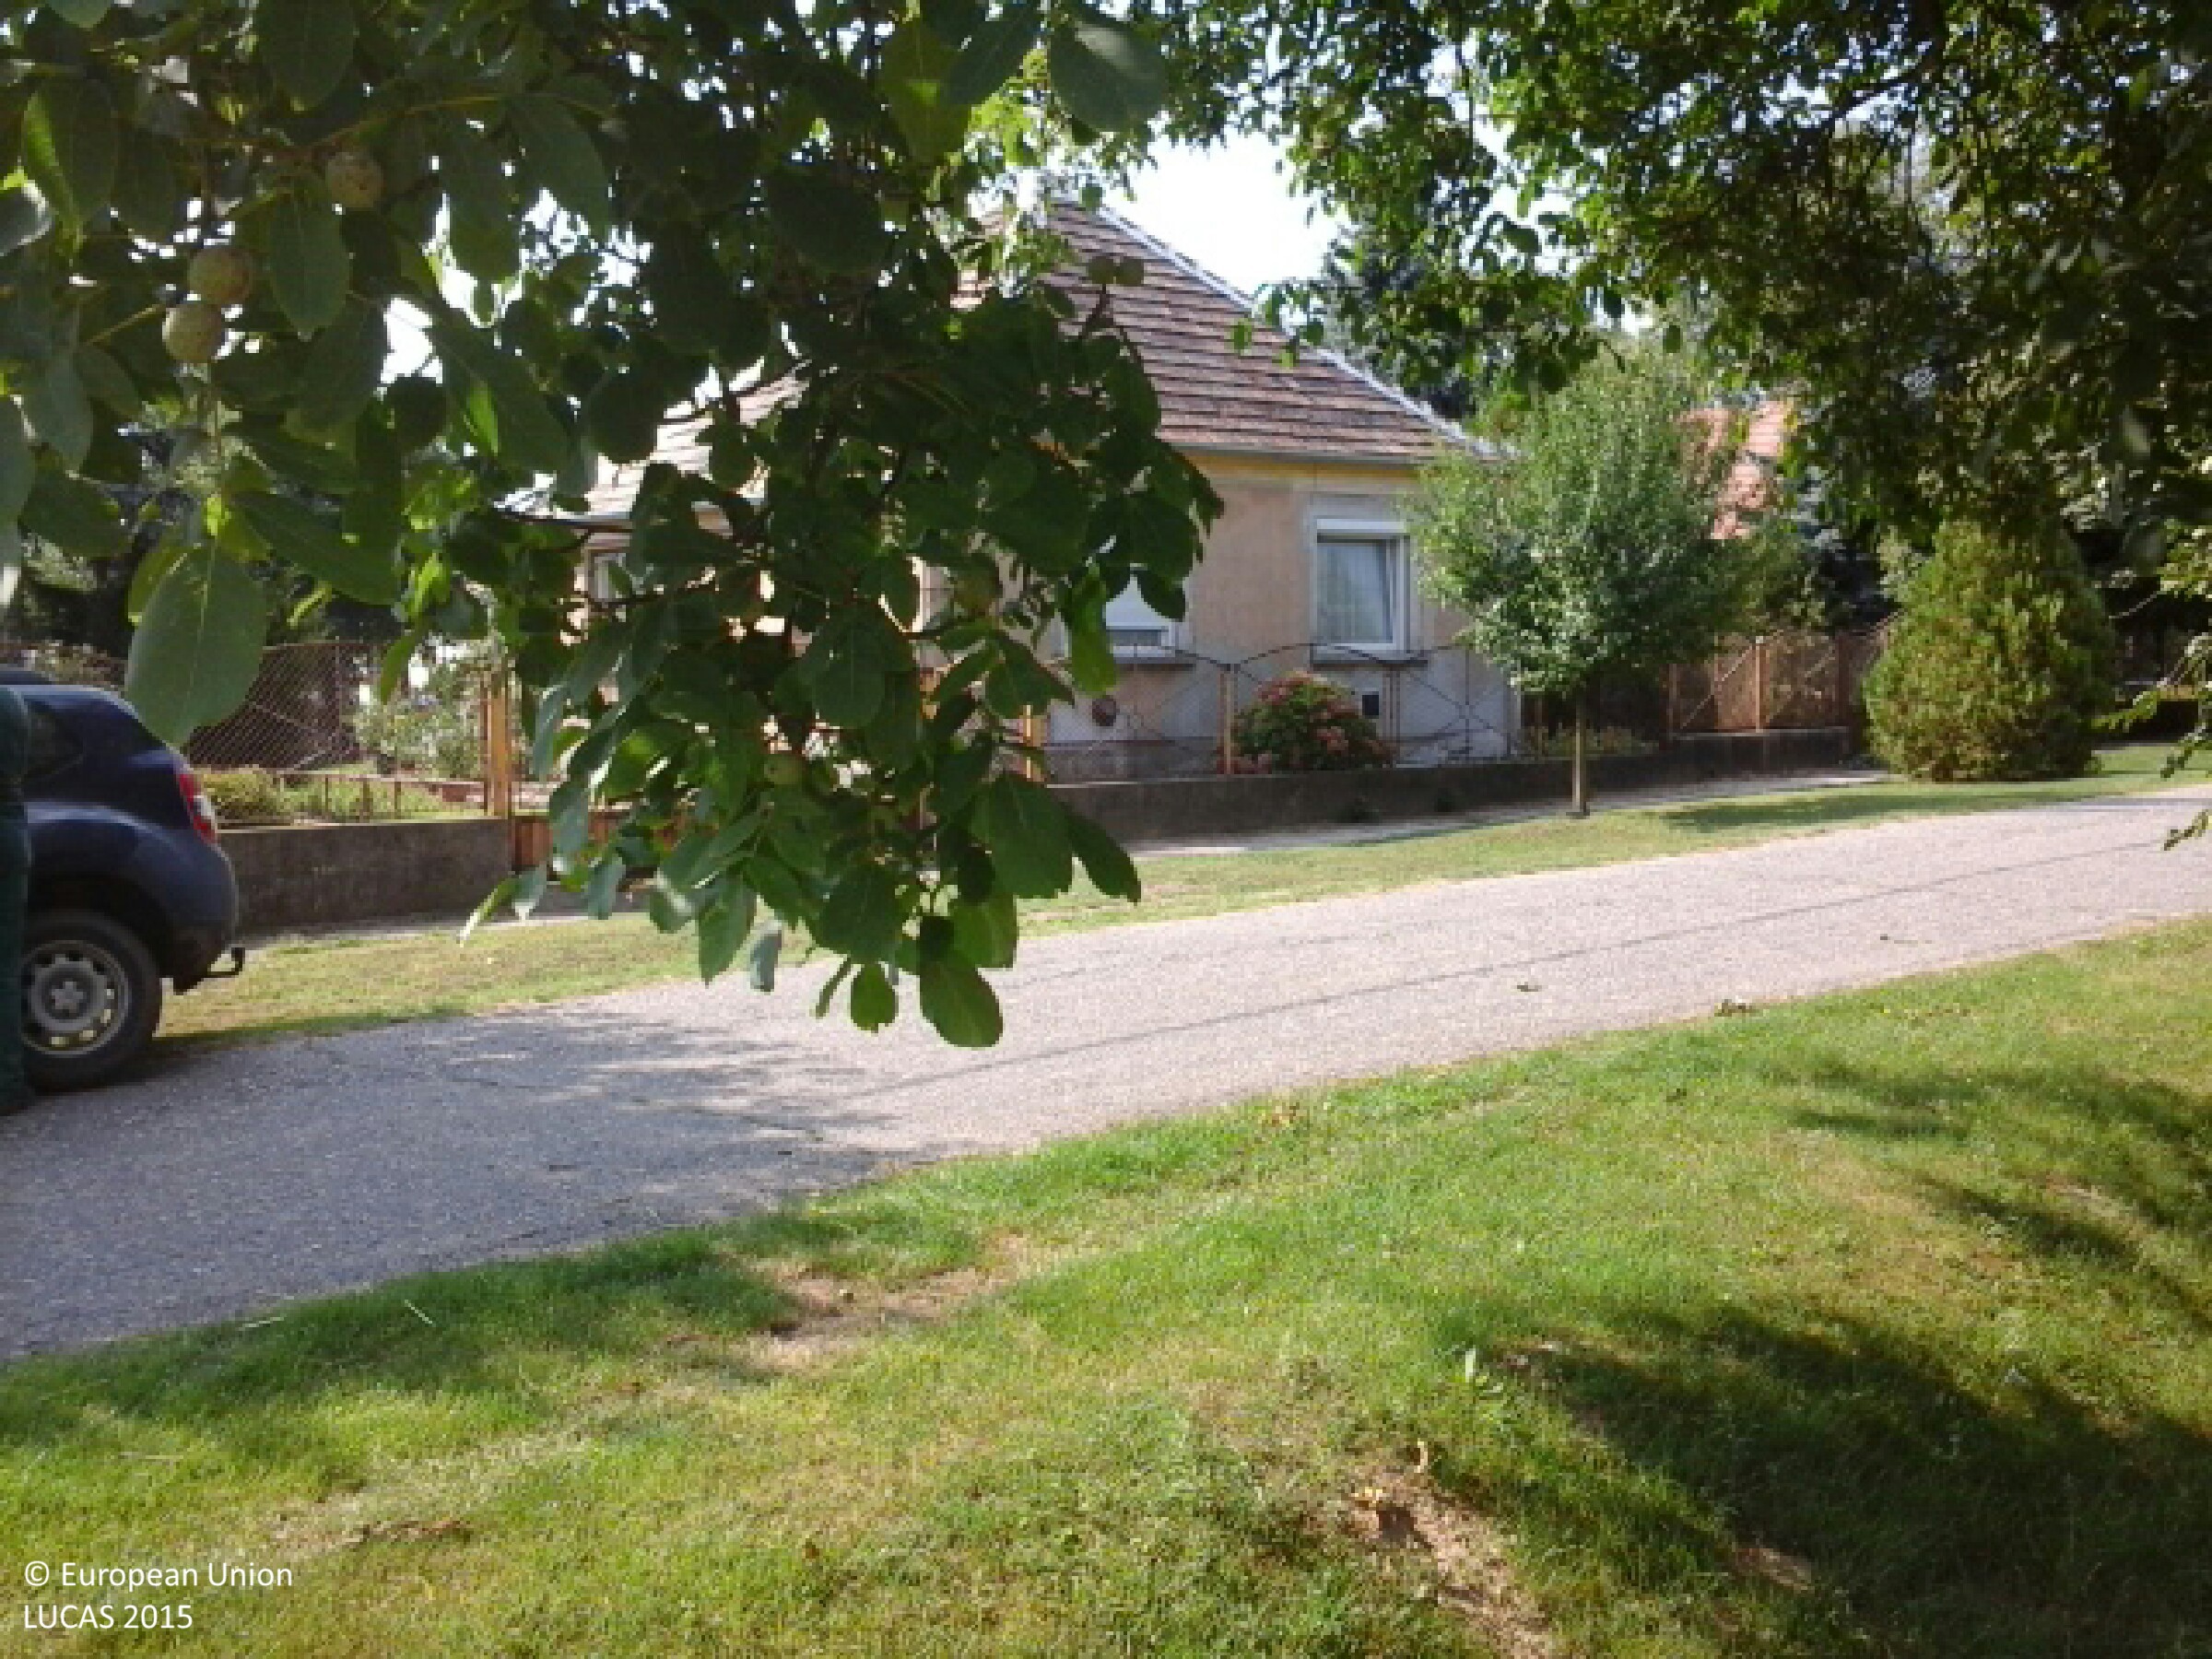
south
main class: Grassland
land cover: Grassland without tree/shrub cover
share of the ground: > 75 %
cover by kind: herbaceous plants 95 %, shrubs 5 %
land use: Residential
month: August
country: HU
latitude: 47.6663
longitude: 18.1758
